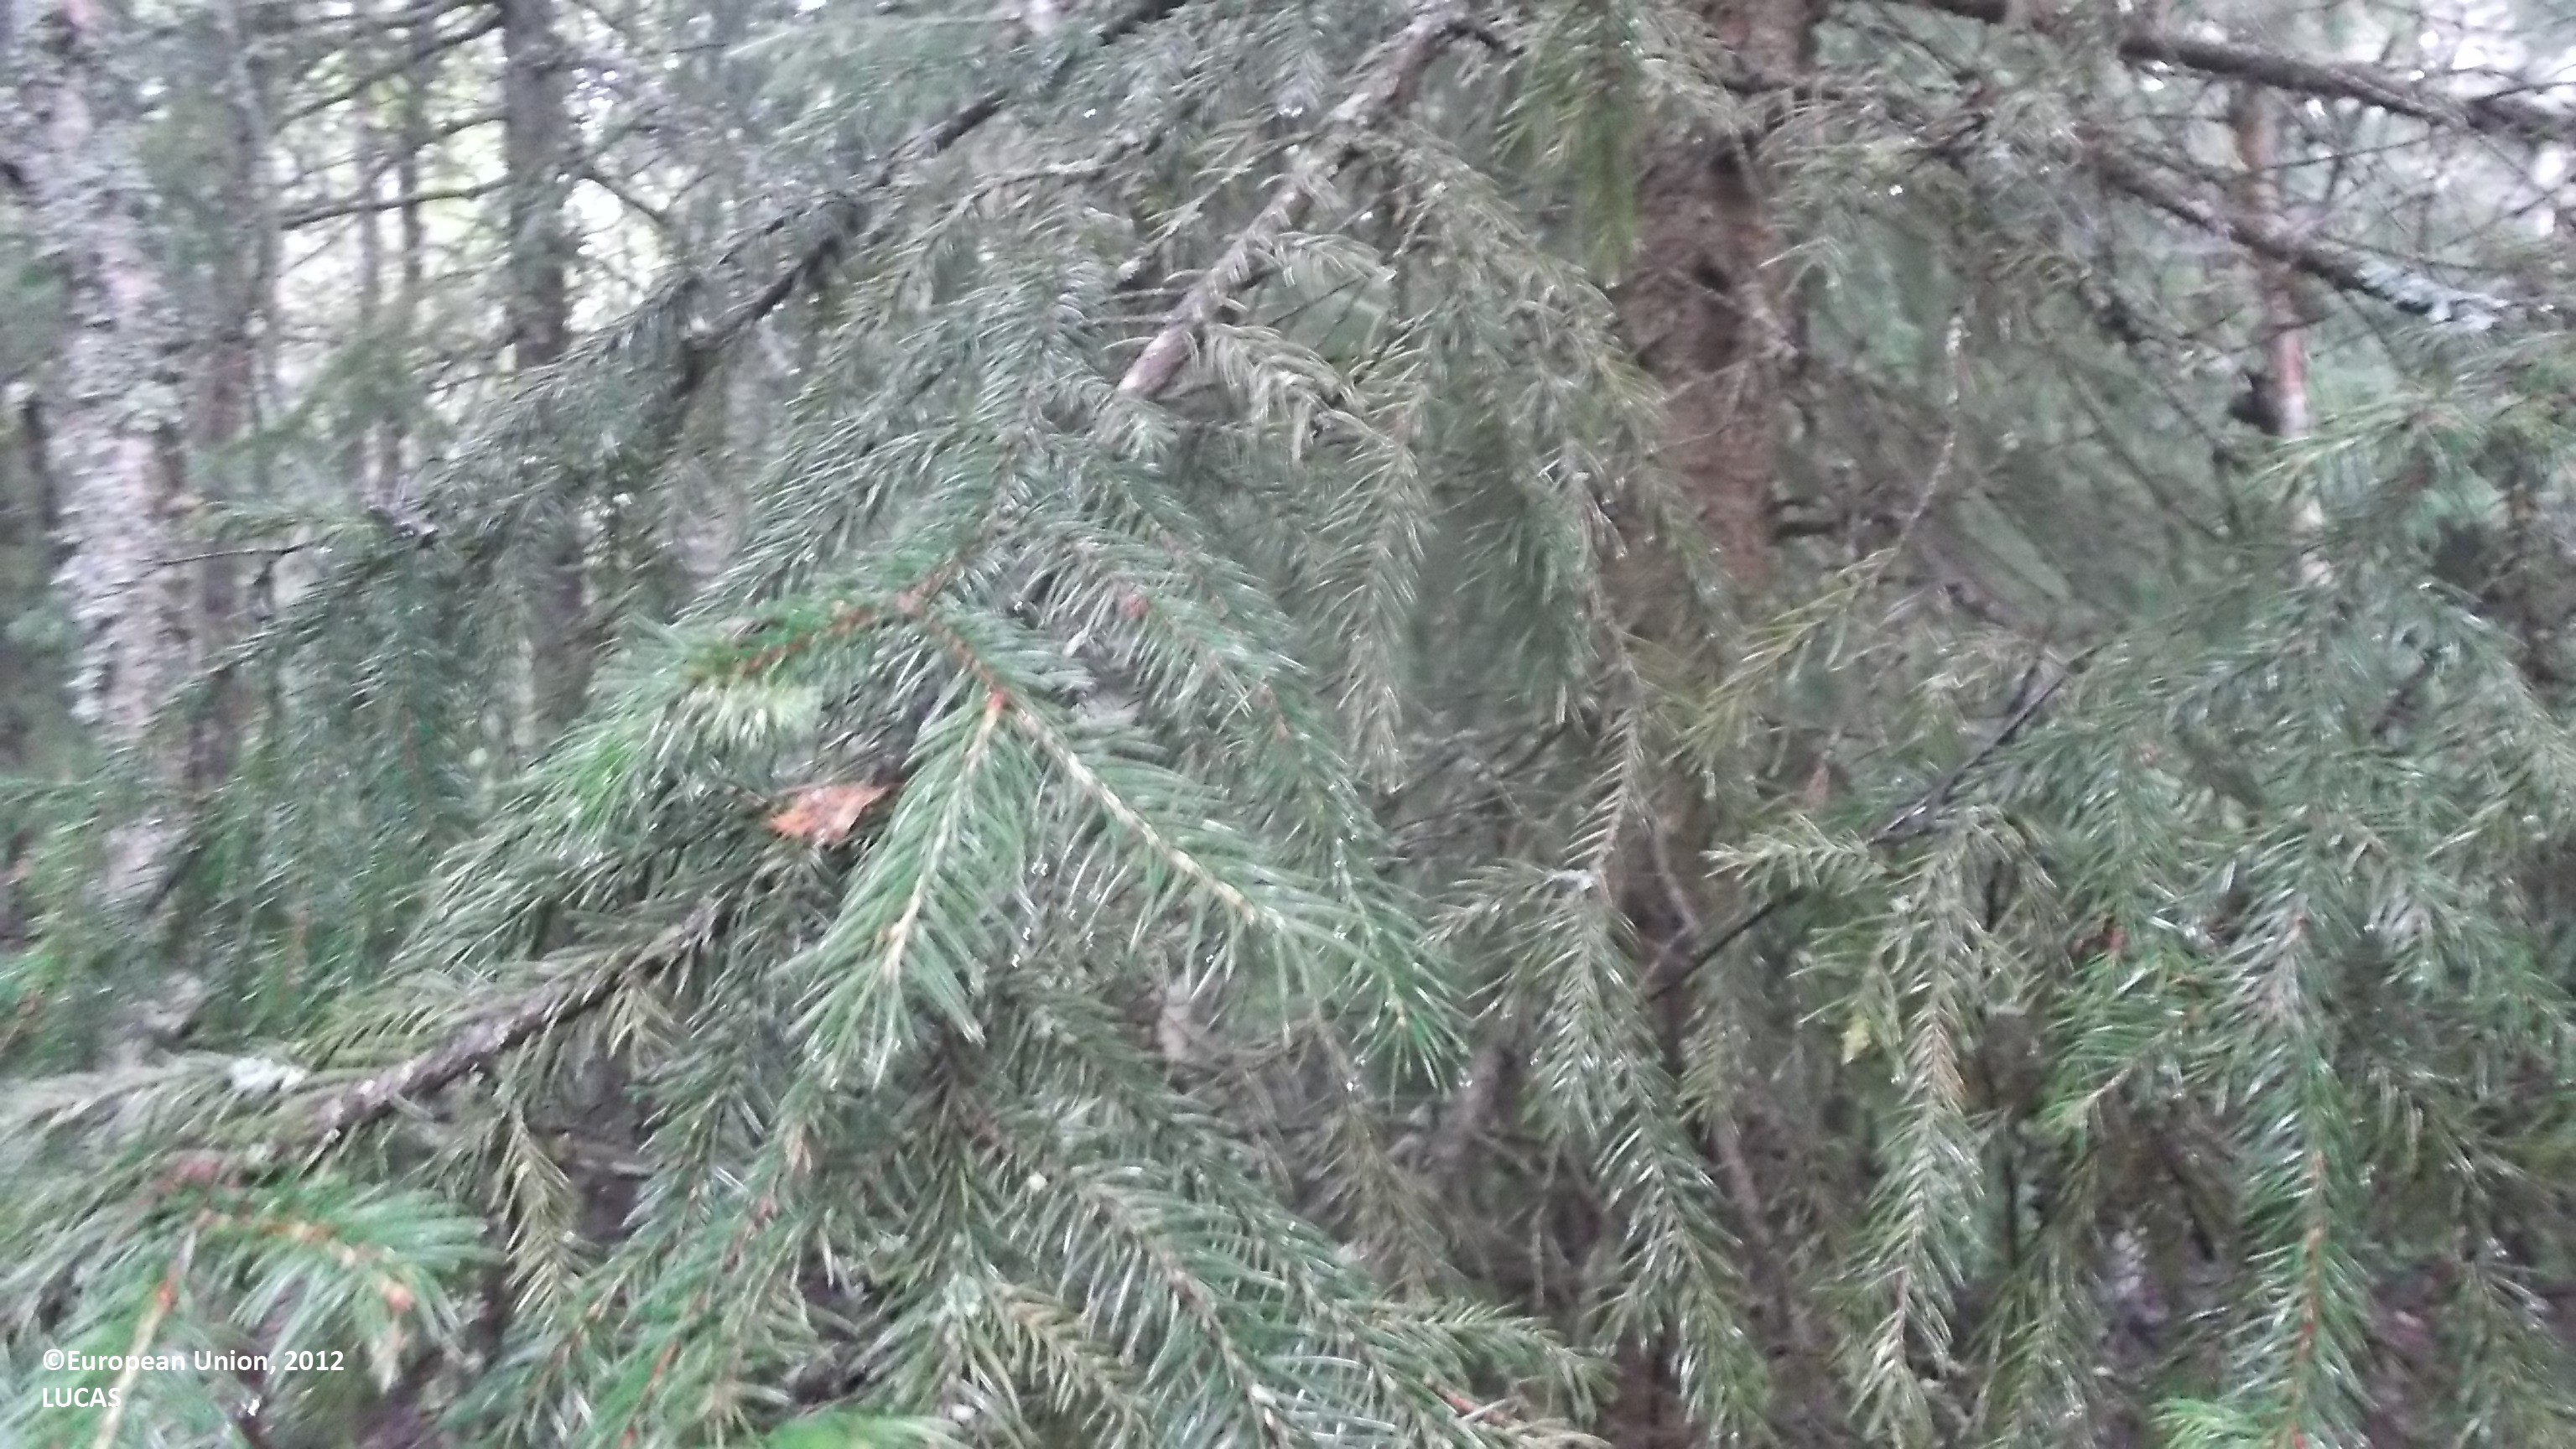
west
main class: Woodland
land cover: Other mixed woodland
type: boreal forest
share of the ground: > 75 %
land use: Forestry
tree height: > 5 m
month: August
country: FI
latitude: 63.8010
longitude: 23.2718
